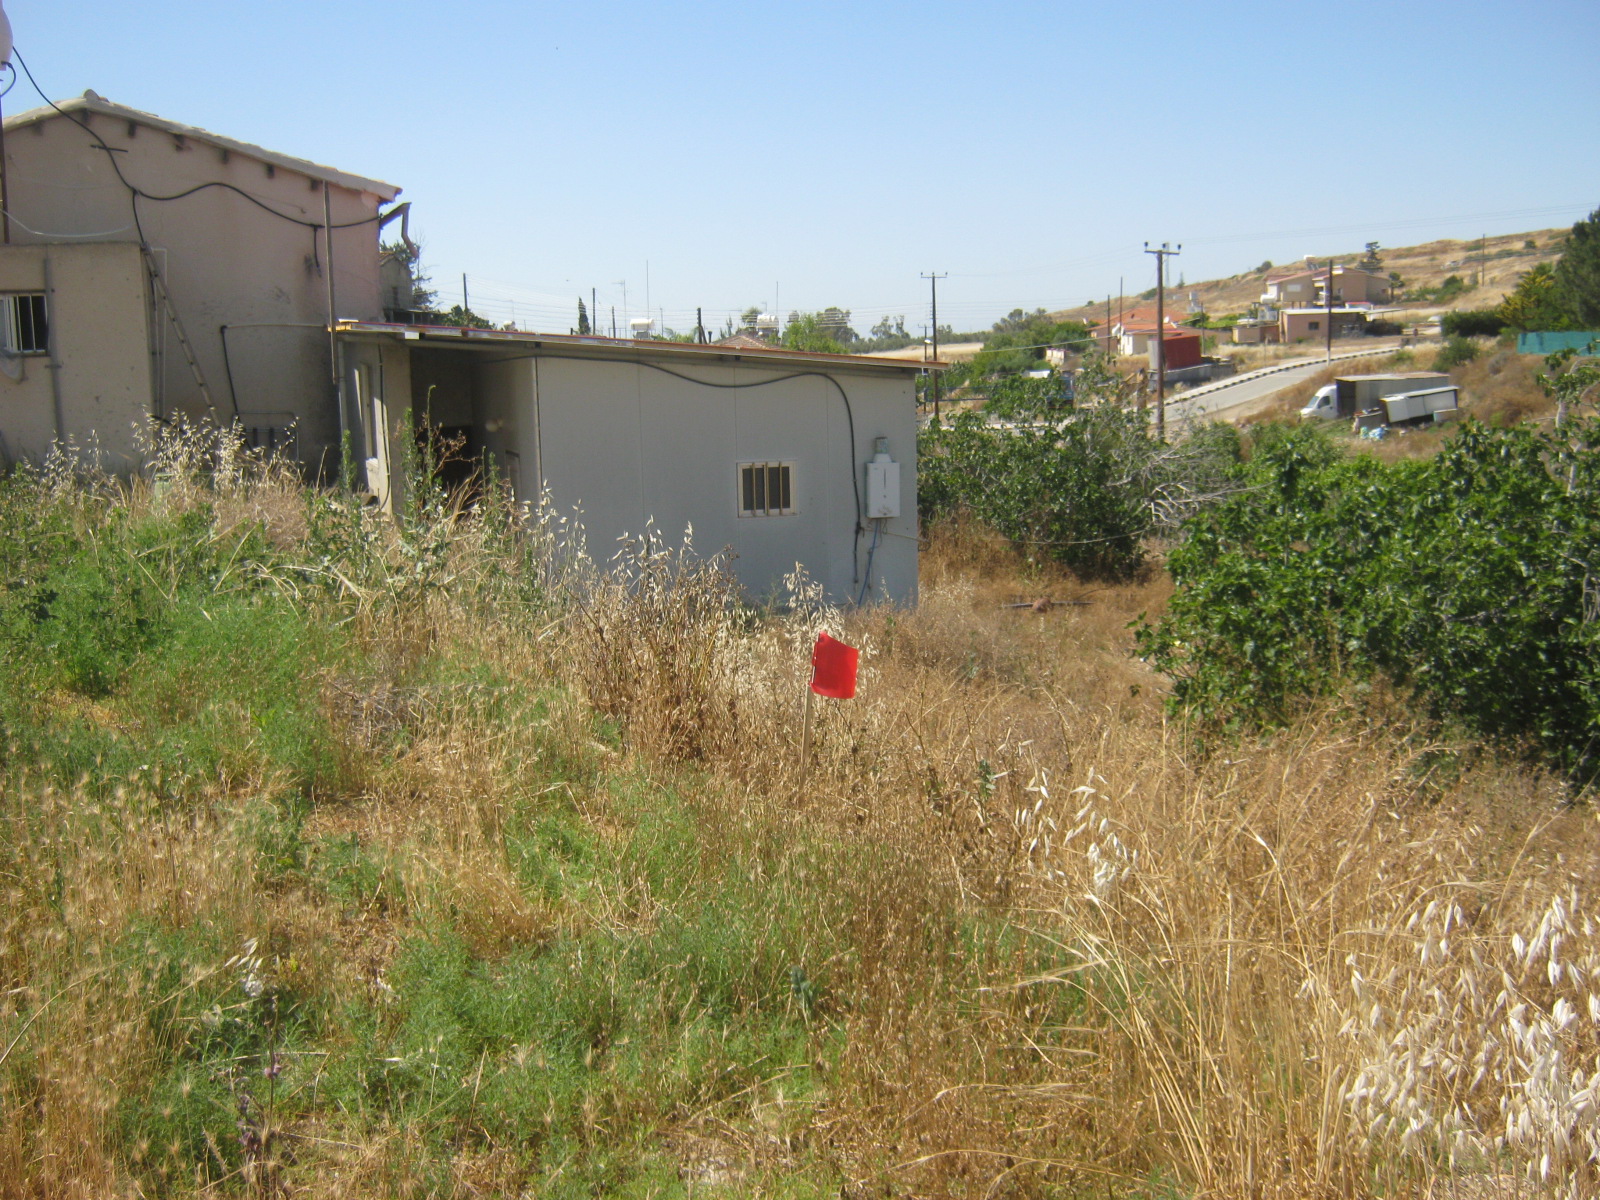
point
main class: Grassland
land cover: Grassland without tree/shrub cover
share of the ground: > 75 %
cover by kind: herbaceous plants 100 %
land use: Residential
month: May
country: CY
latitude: 35.1049
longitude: 33.0307
